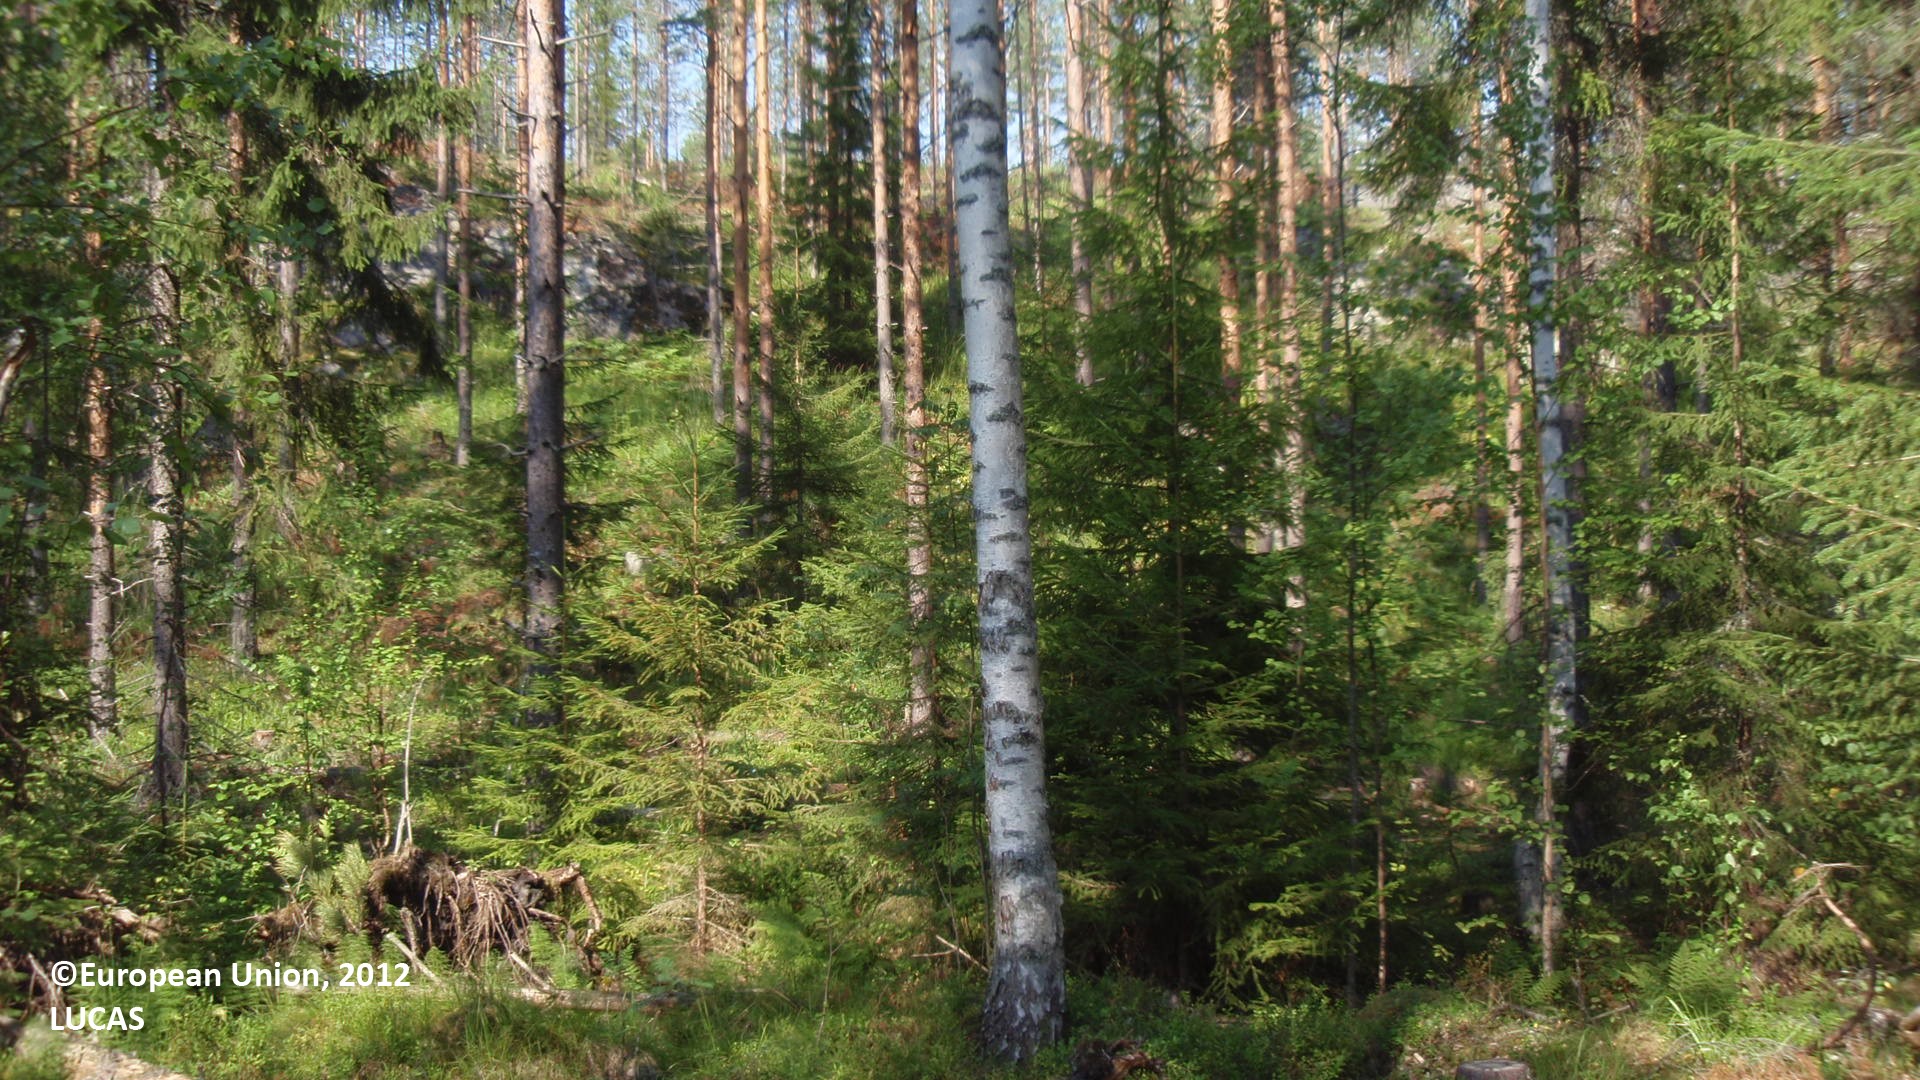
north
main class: Woodland
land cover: Pine dominated coniferous woodland
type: boreal forest
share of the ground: 50 - 75 %
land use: Forestry
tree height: > 5 m
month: July
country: FI
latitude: 61.3889
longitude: 28.3861
